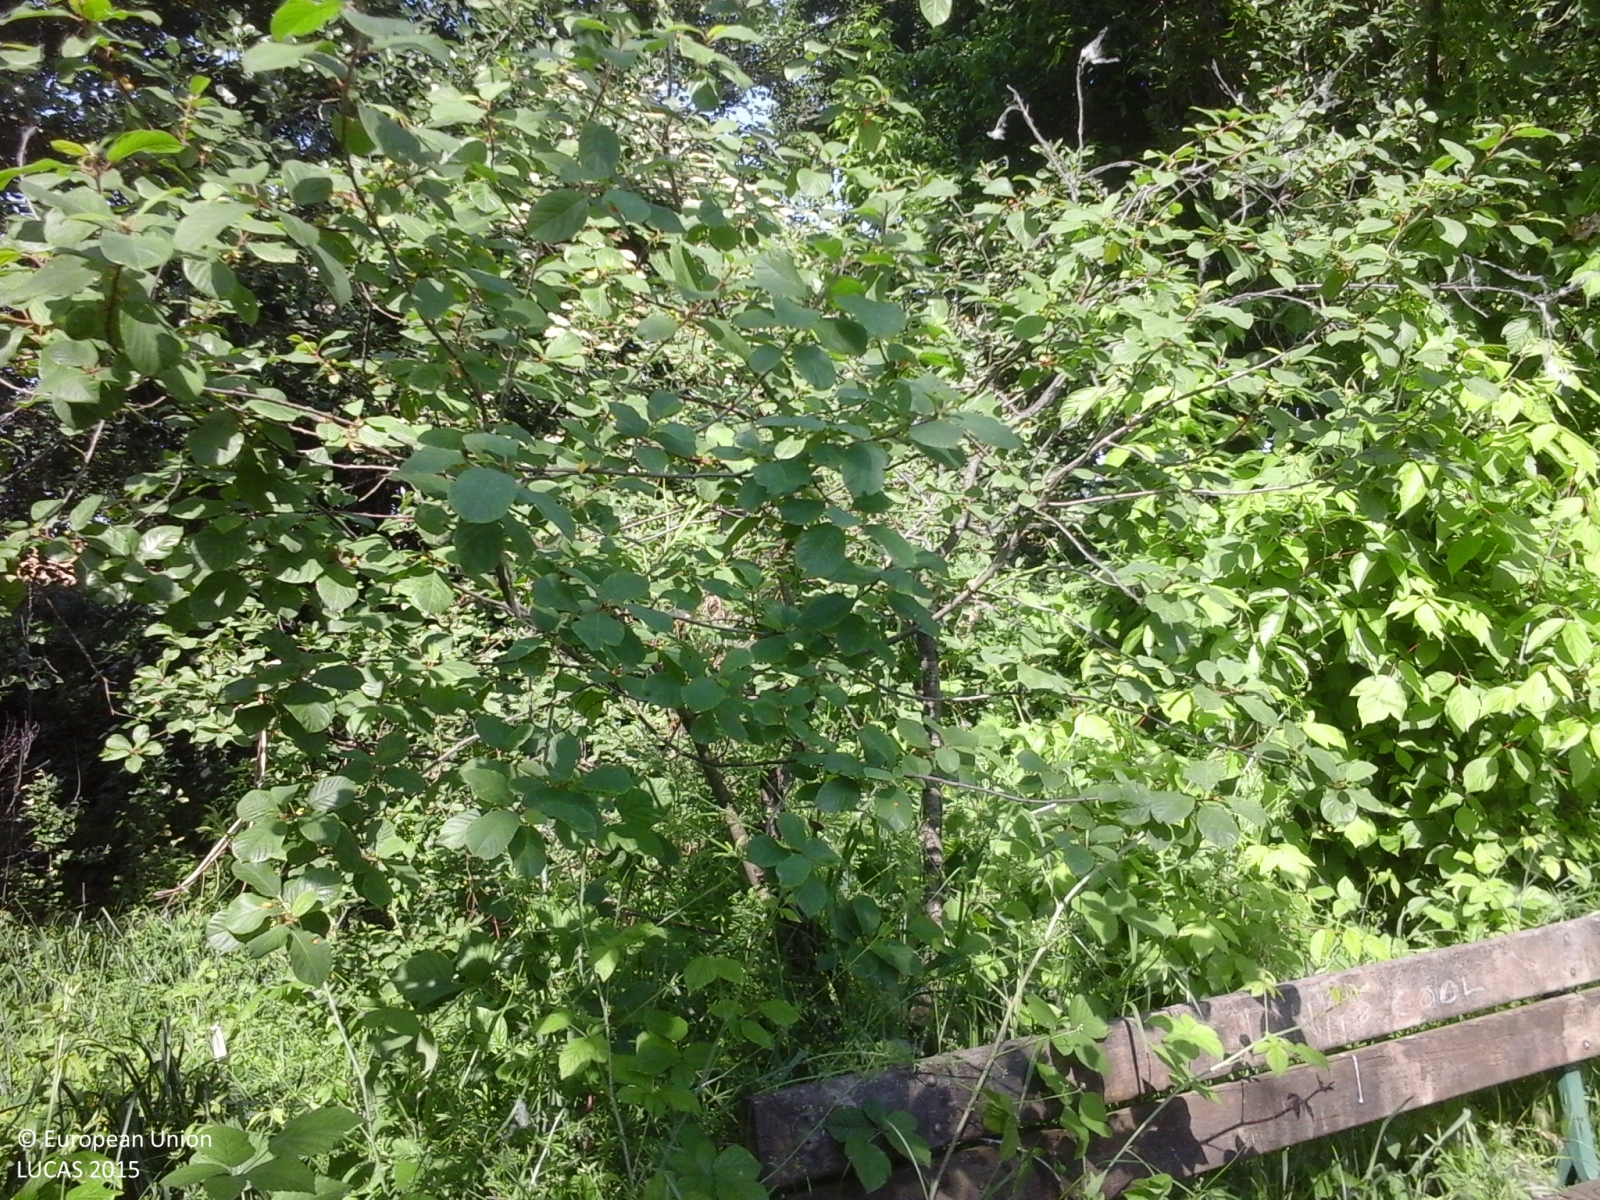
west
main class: Shrubland
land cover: Shrubland with sparse tree cover
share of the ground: > 75 %
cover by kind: shrubs 70 %, herbaceous plants 25 %, broadleaved forest trees 5 %
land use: Semi-natural and natural areas not in use
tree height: > 5 m
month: May
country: IT
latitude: 45.2308
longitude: 9.1736
